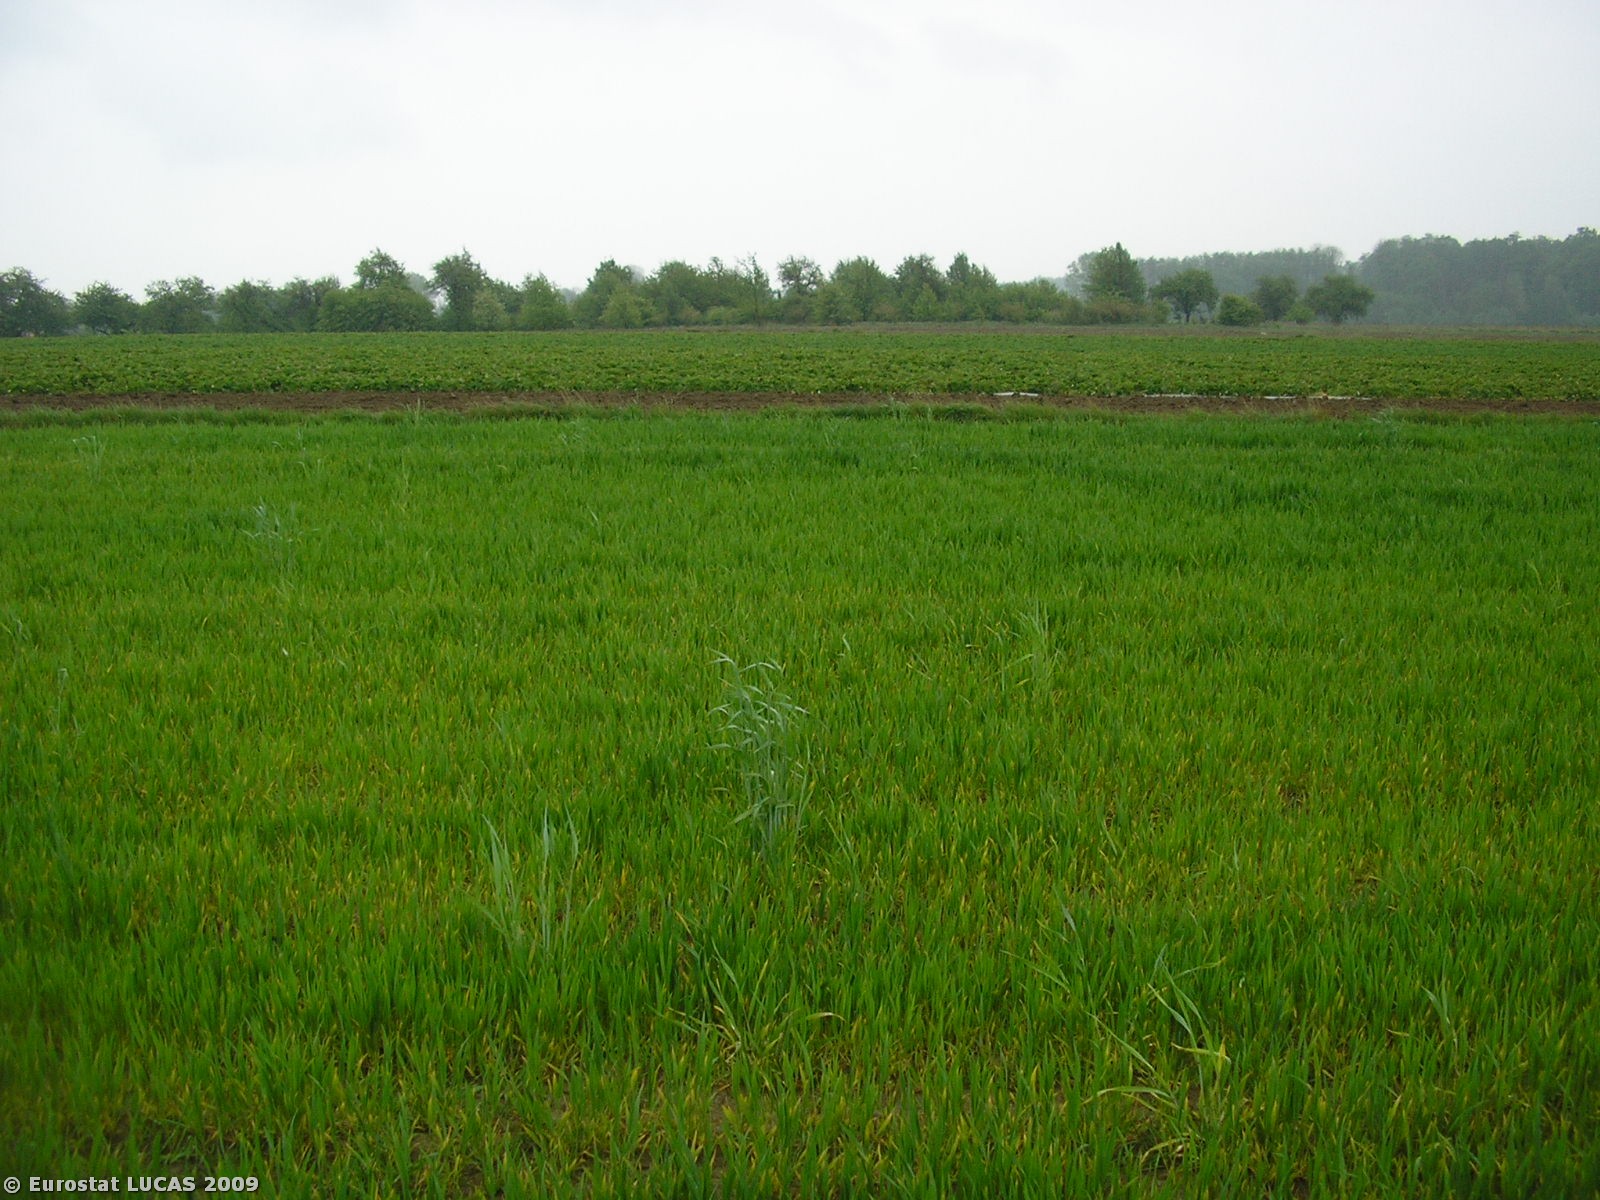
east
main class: Cropland
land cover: Common wheat
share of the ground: > 75 %
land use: Agriculture (excluding fallow land and kitchen gardens)
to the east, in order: Common wheat; Potatoes; Strawberries; Paved roads, cycling and walking lanes; Strawberries; Maize; Other fruit trees and berries; Grassland with sparse tree/shrub cover; Strawberries
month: June
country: PL
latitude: 52.4546
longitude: 20.2925
